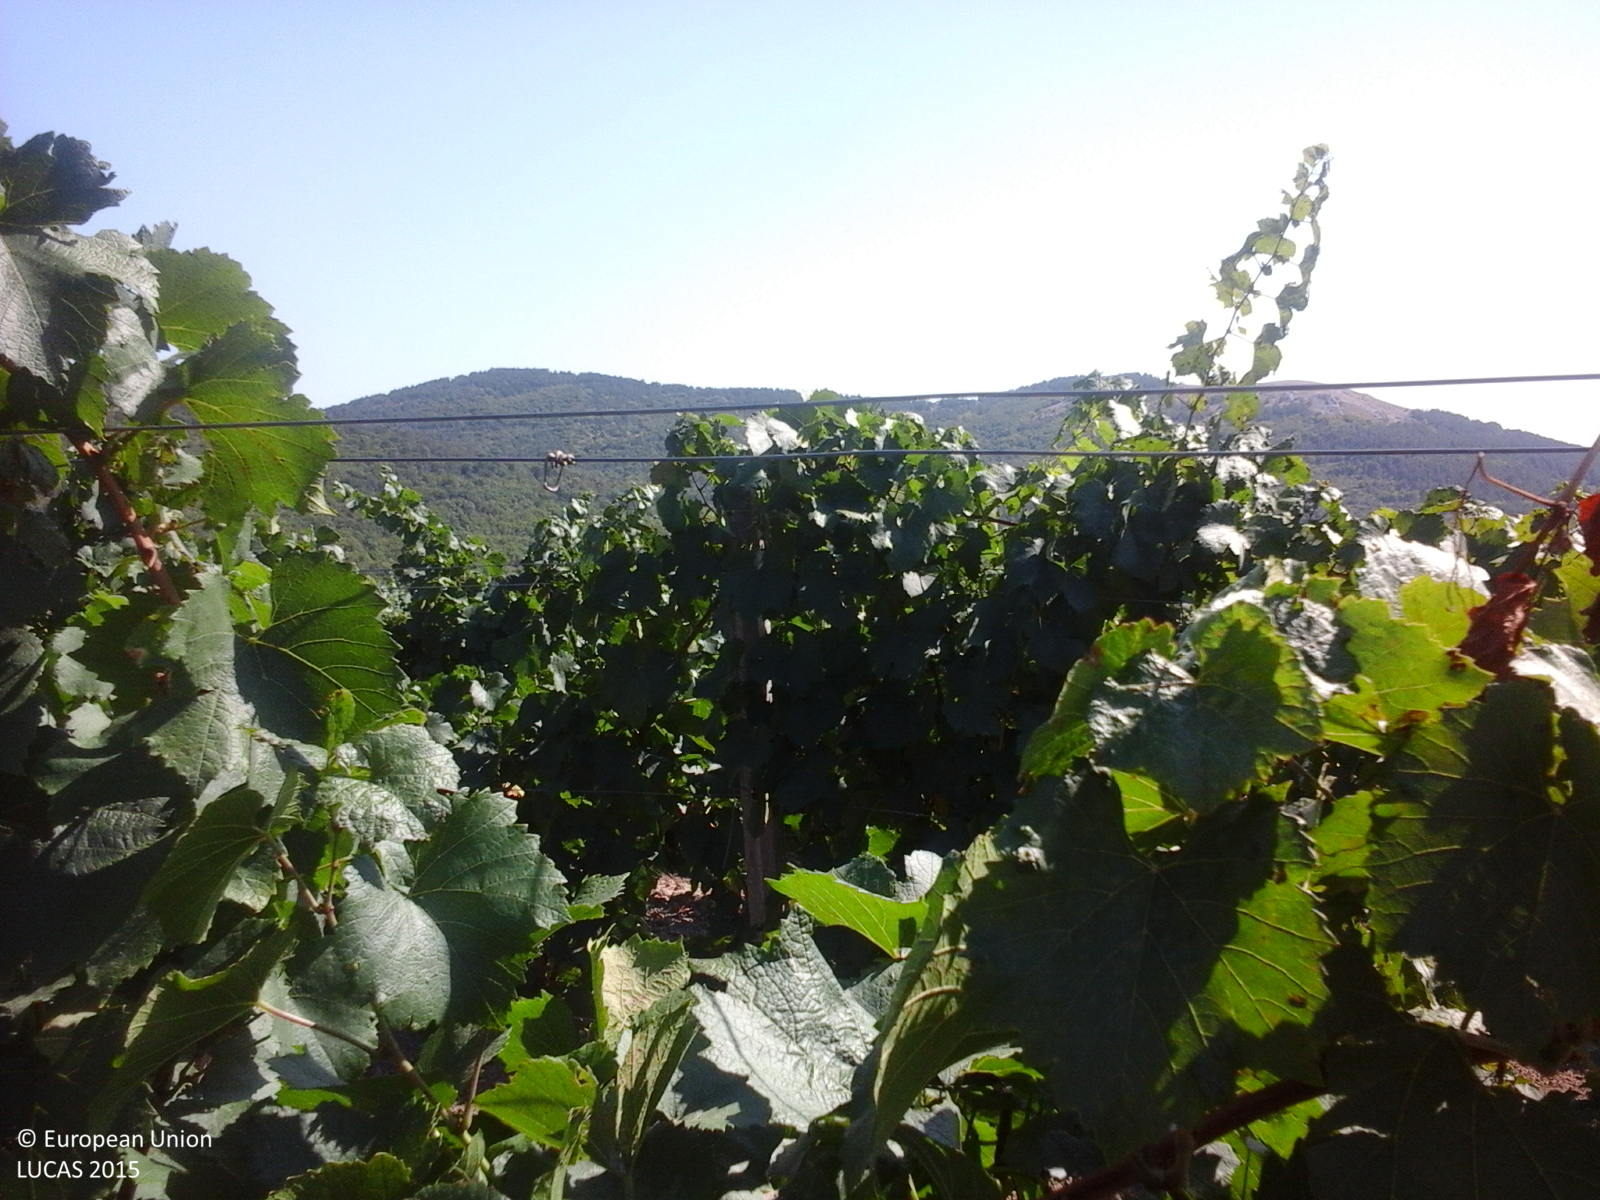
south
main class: Cropland
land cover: Vineyards
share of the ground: 50 - 75 %
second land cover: Other bare soil
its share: > 75 %
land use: Agriculture (excluding fallow land and kitchen gardens)
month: August
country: RO
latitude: 44.5114
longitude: 28.2162
